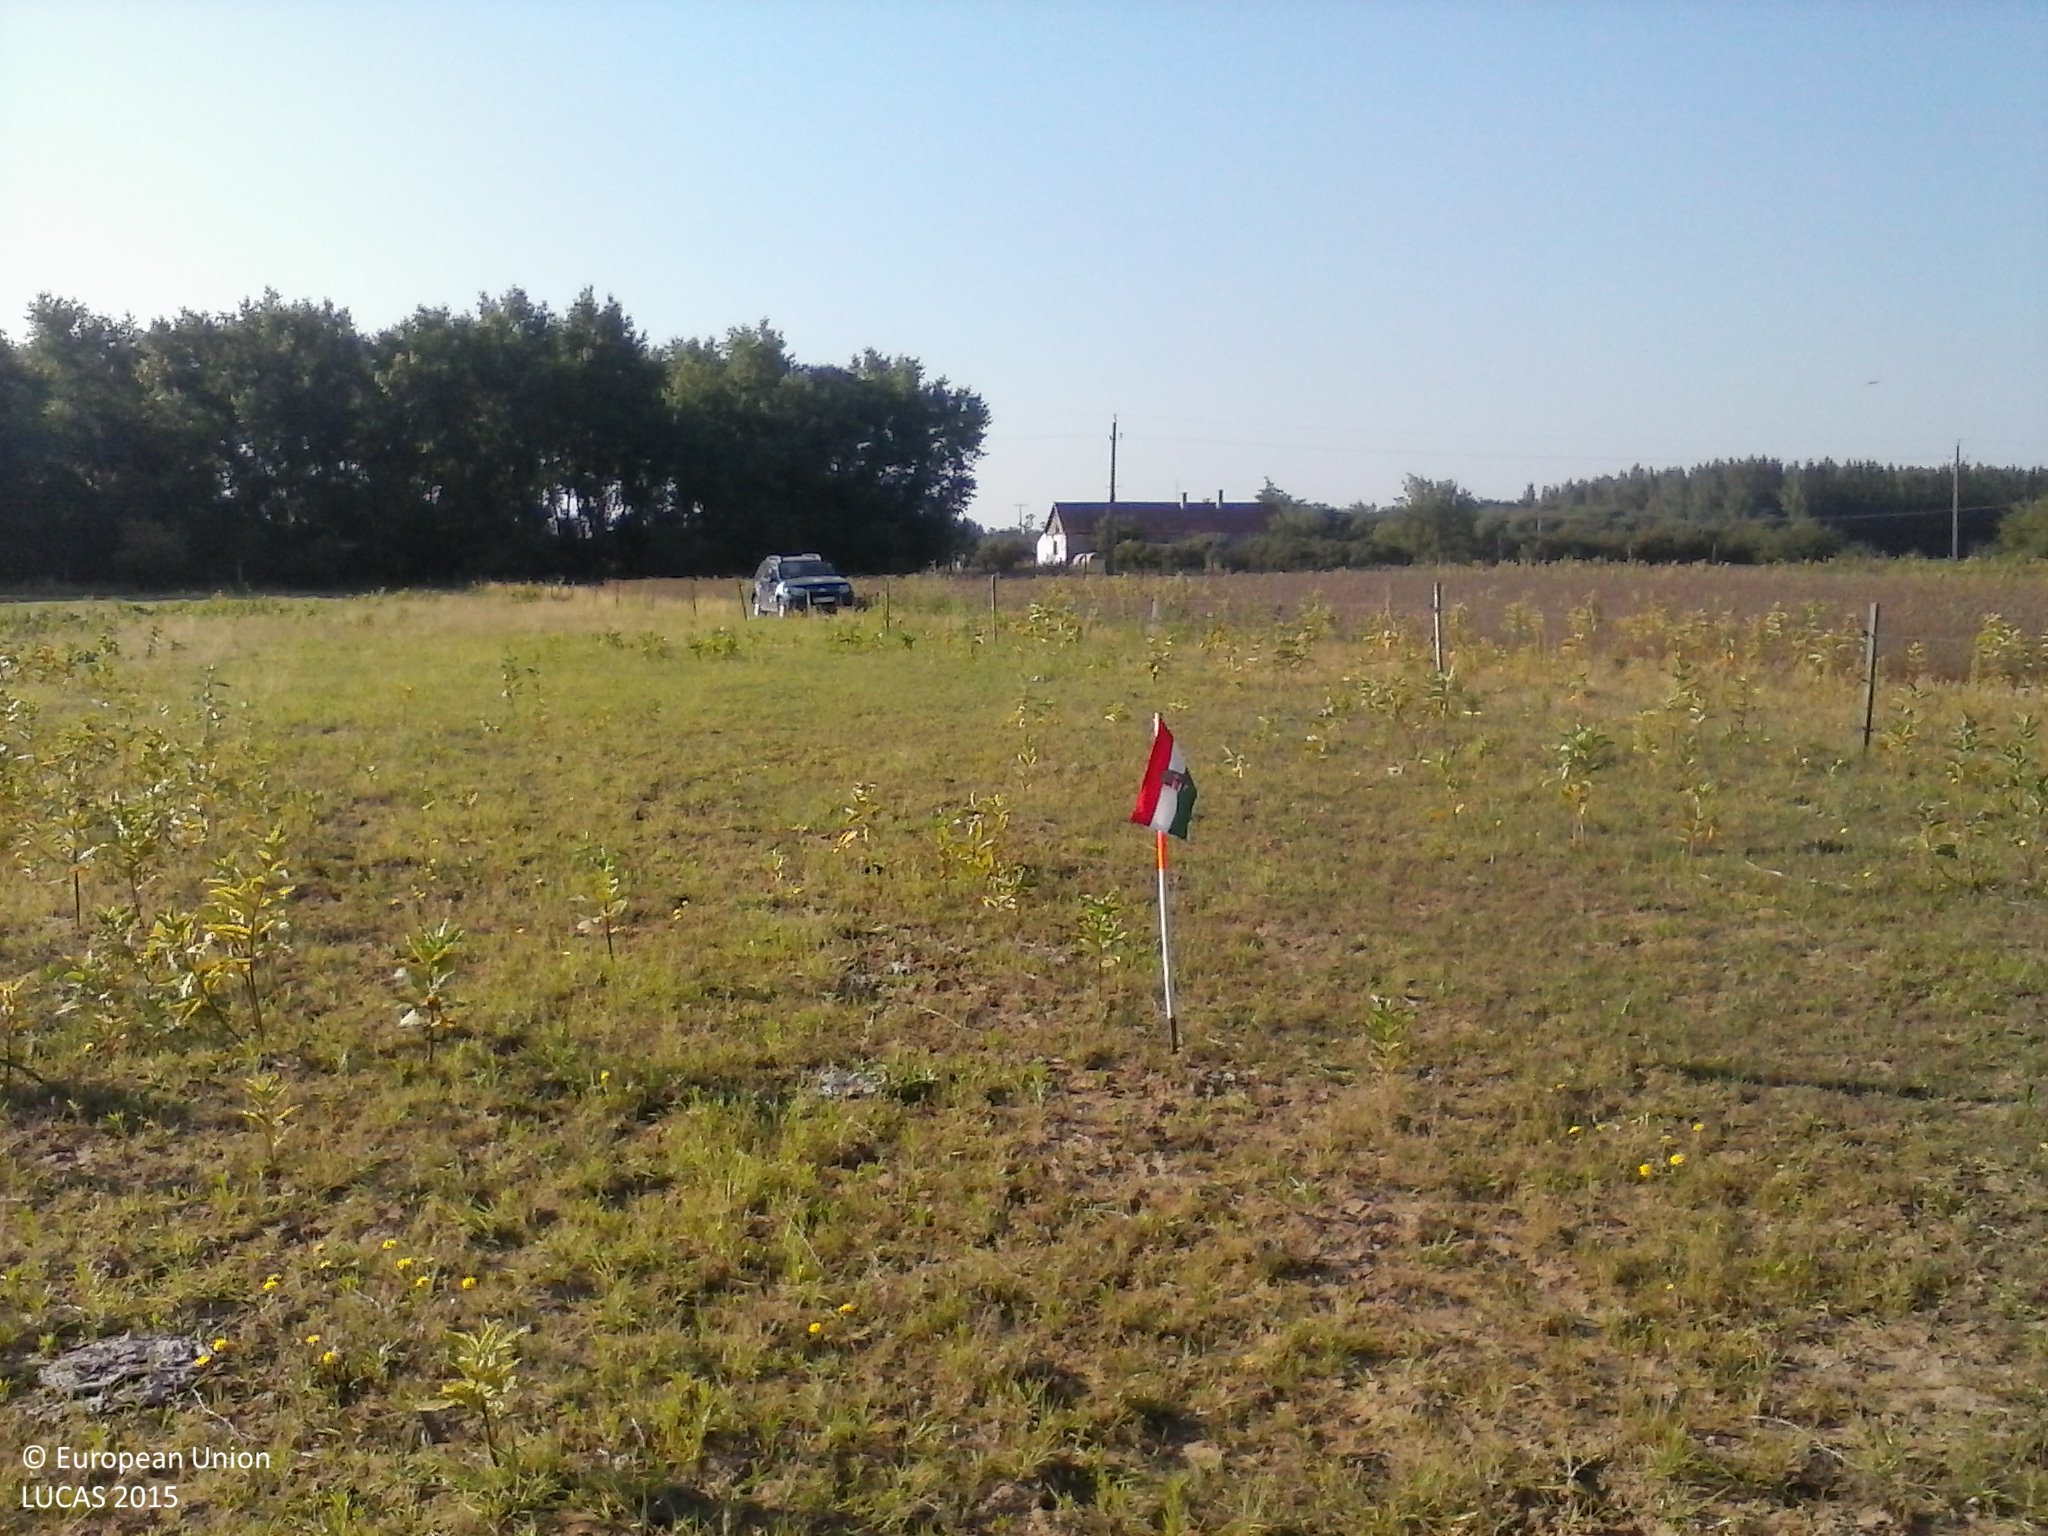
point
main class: Grassland
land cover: Spontaneously vegetated surfaces
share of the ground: > 75 %
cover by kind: herbaceous plants 90 %, unconsolidated bare surface 10 %
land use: Agriculture (excluding fallow land and kitchen gardens)
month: July
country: HU
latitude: 46.3339
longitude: 19.6179
